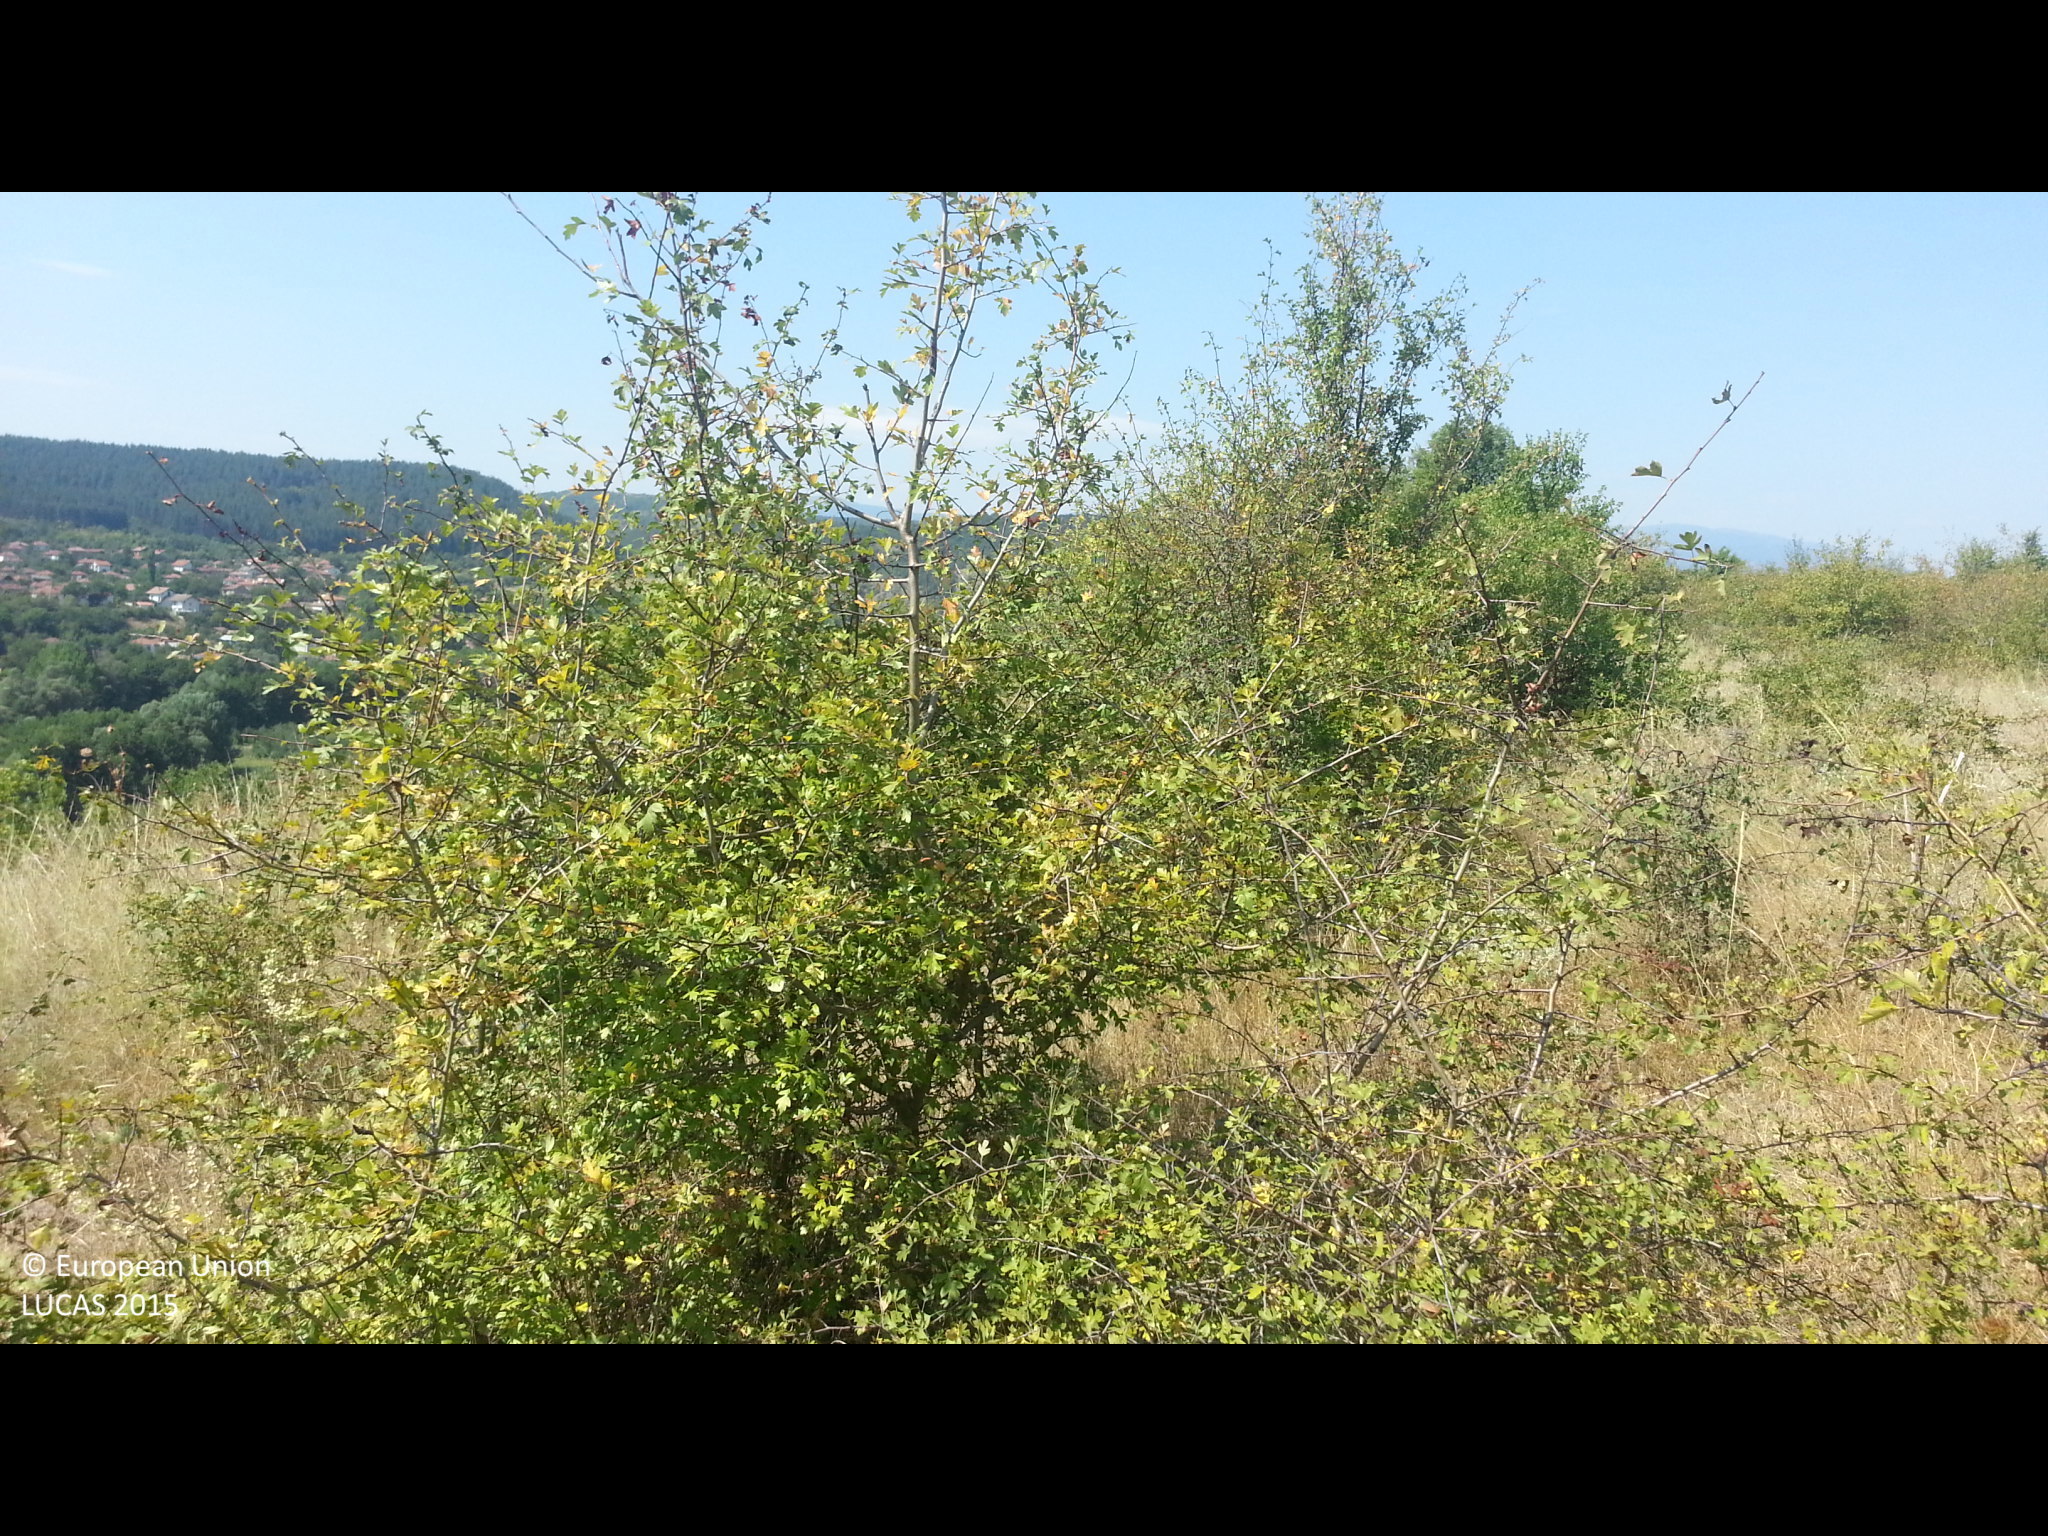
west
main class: Grassland
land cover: Grassland with sparse tree/shrub cover
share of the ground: > 75 %
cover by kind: herbaceous plants 85 %, shrubs 10 %, broadleaved forest trees 5 %
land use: Abandoned areas
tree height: < 5 m
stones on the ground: 10 - 25 %
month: August
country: BG
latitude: 42.2476
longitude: 22.8830
